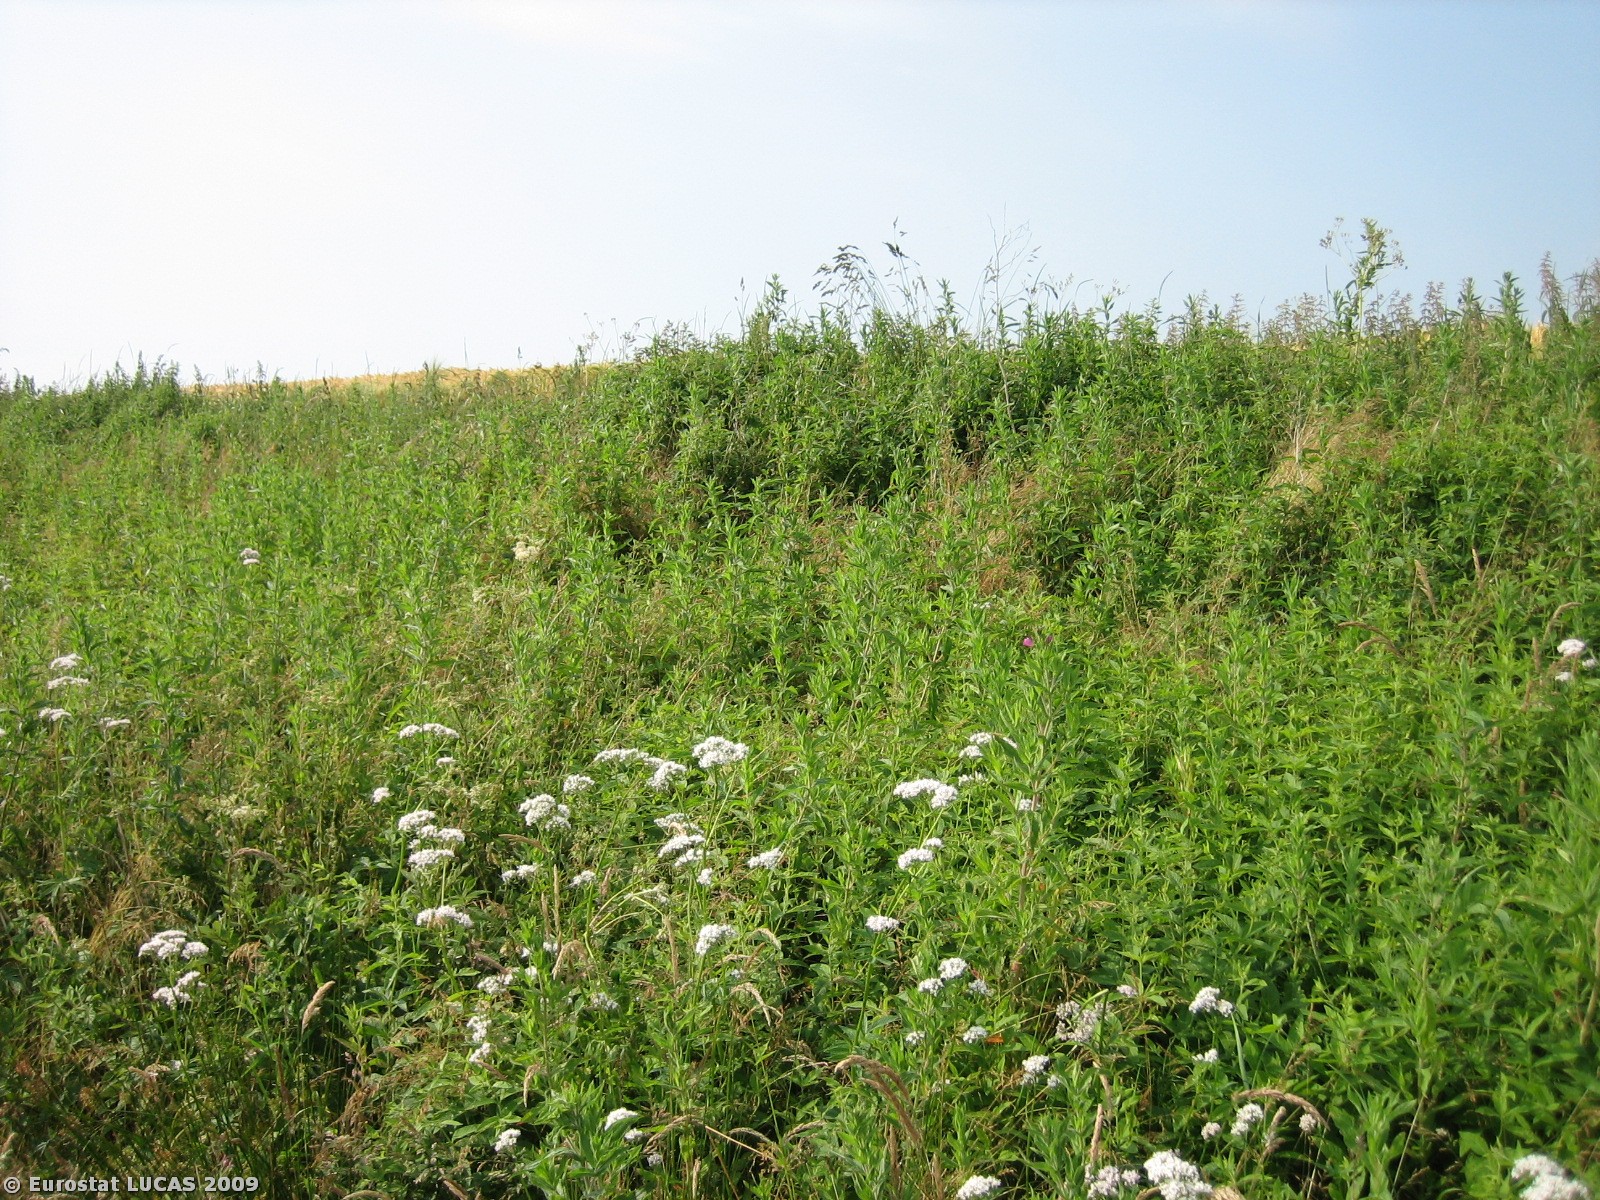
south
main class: Grassland
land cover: Grassland without tree/shrub cover
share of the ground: > 75 %
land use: Unused
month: July
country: DK
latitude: 55.3018
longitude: 8.8511
